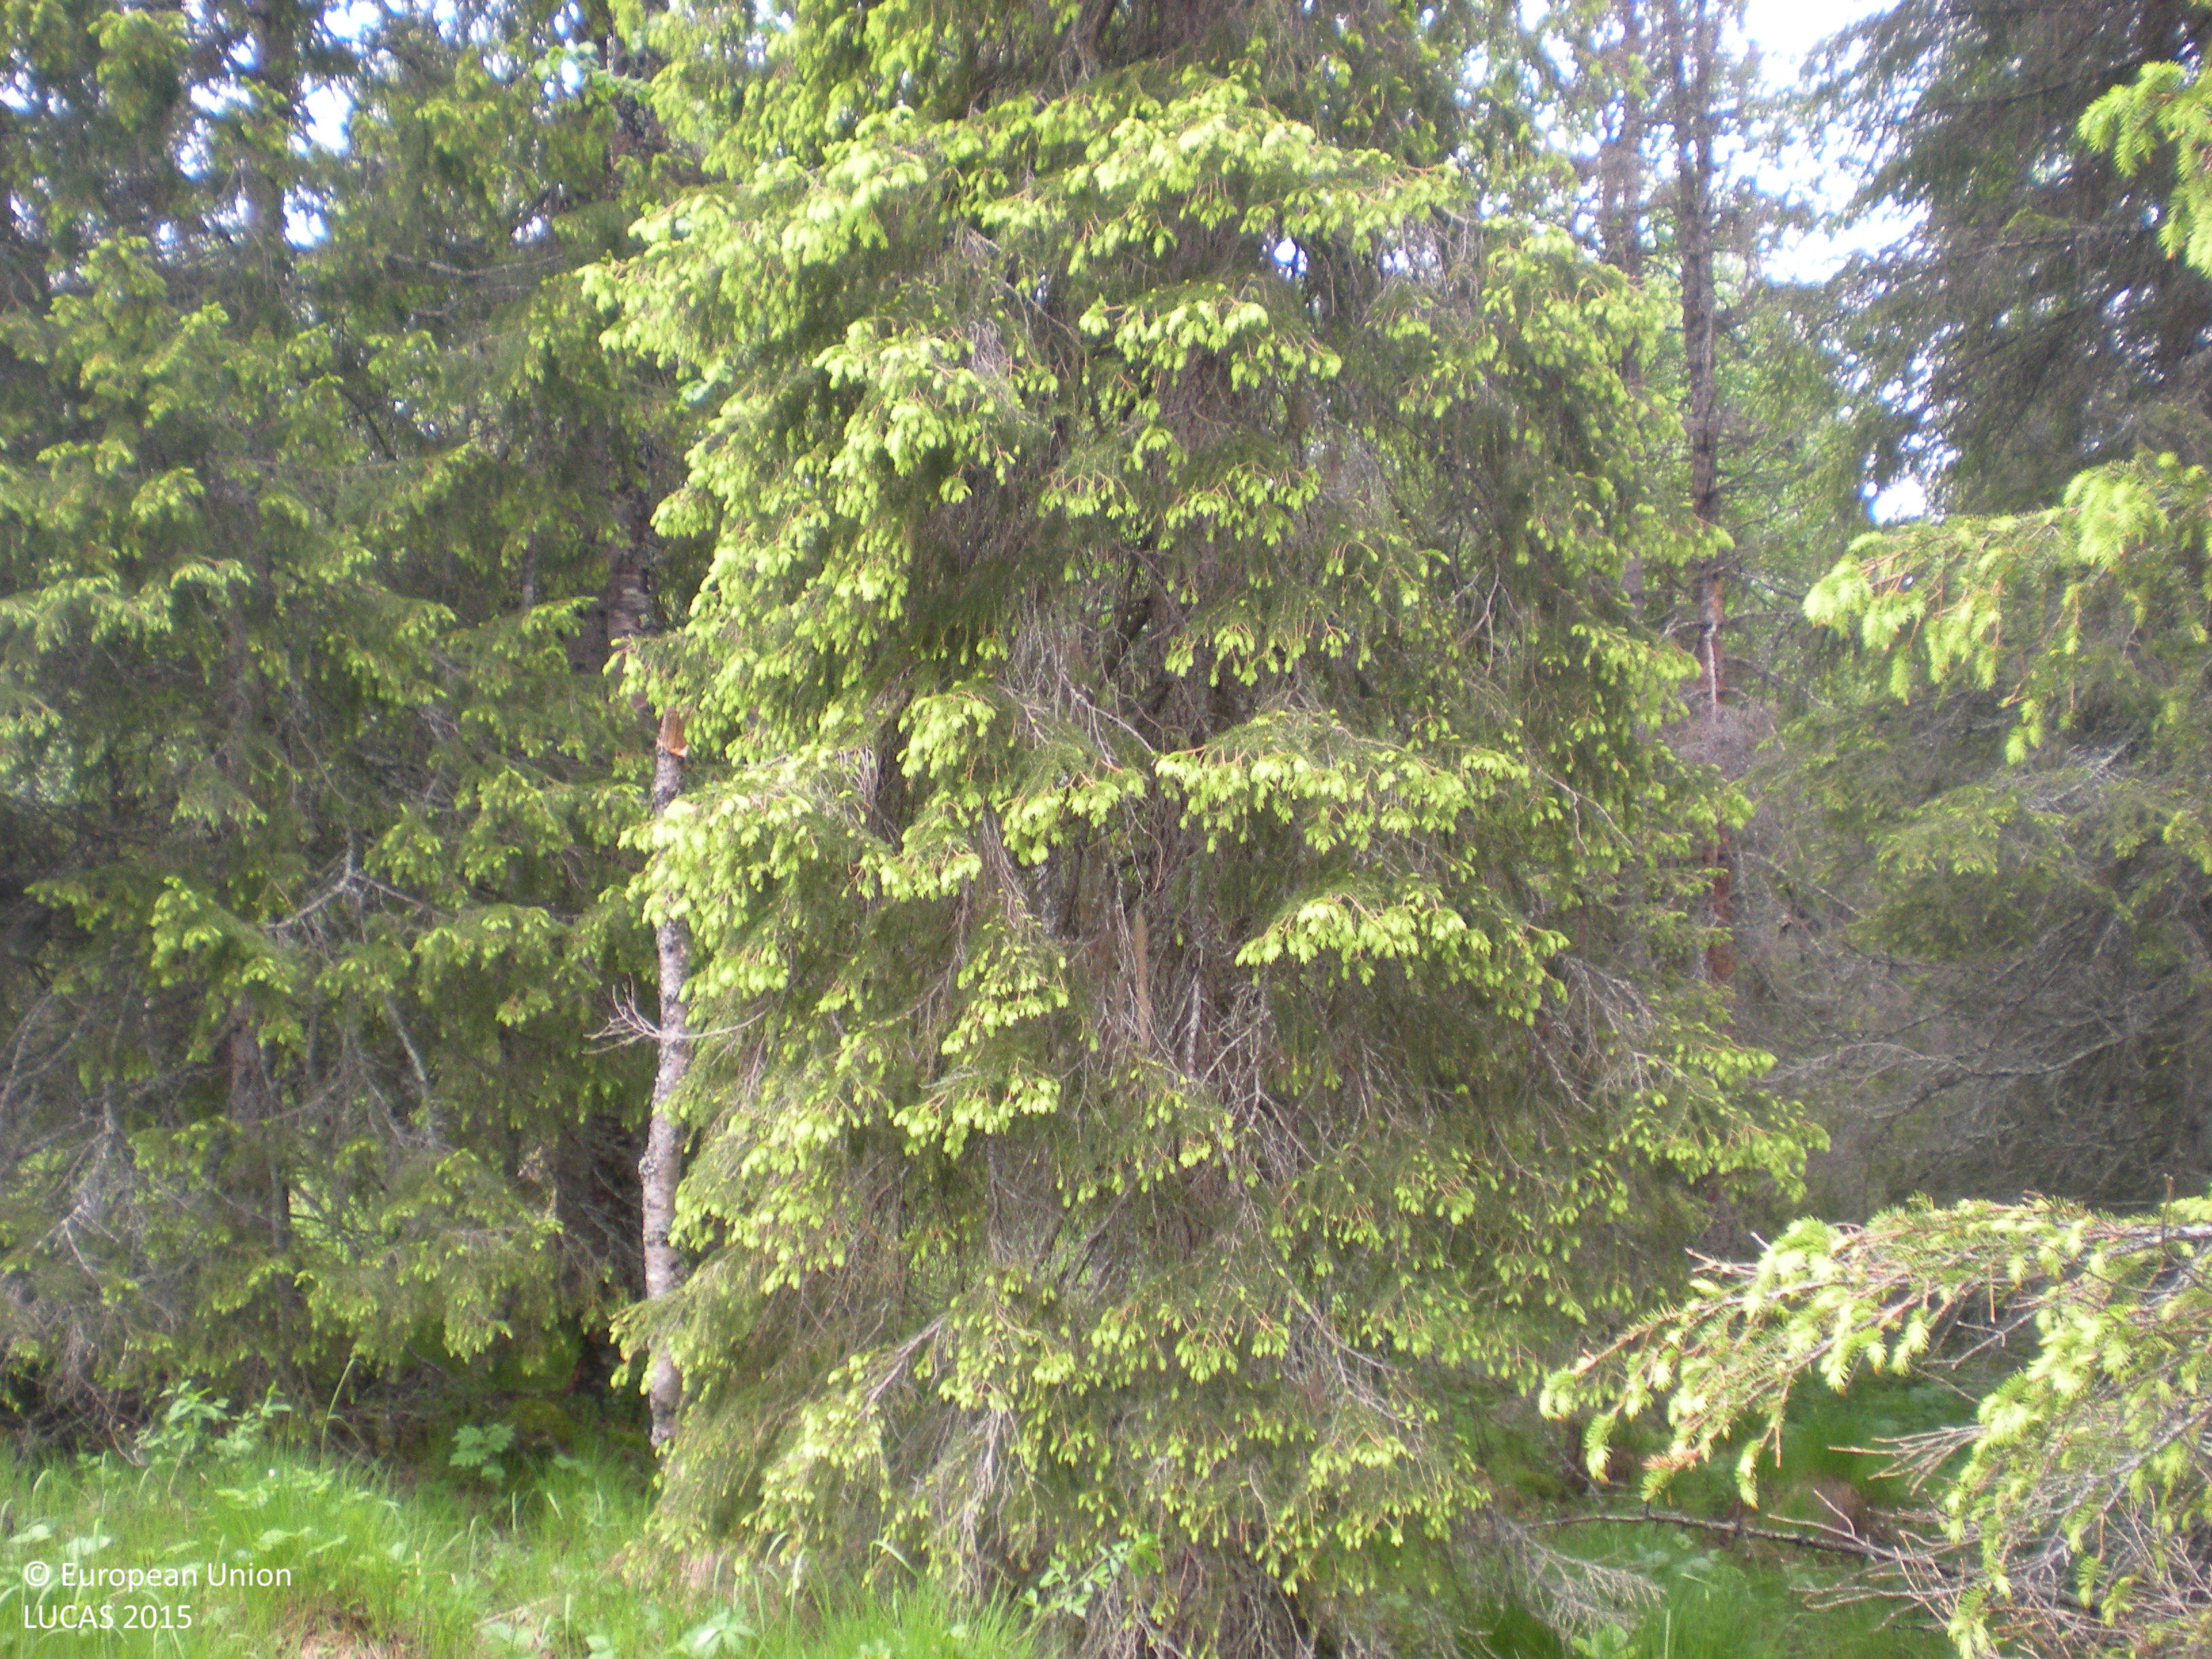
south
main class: Woodland
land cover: Spruce dominated mixed woodland
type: boreal forest
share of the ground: 50 - 75 %
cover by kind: coniferous forest trees 50 %, broadleaved forest trees 20 %, shrubs 15 %, herbaceous plants 10 %, lichens and mosses 5 %
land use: Forestry
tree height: > 5 m
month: July
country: SE
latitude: 66.0874
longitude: 17.1854
